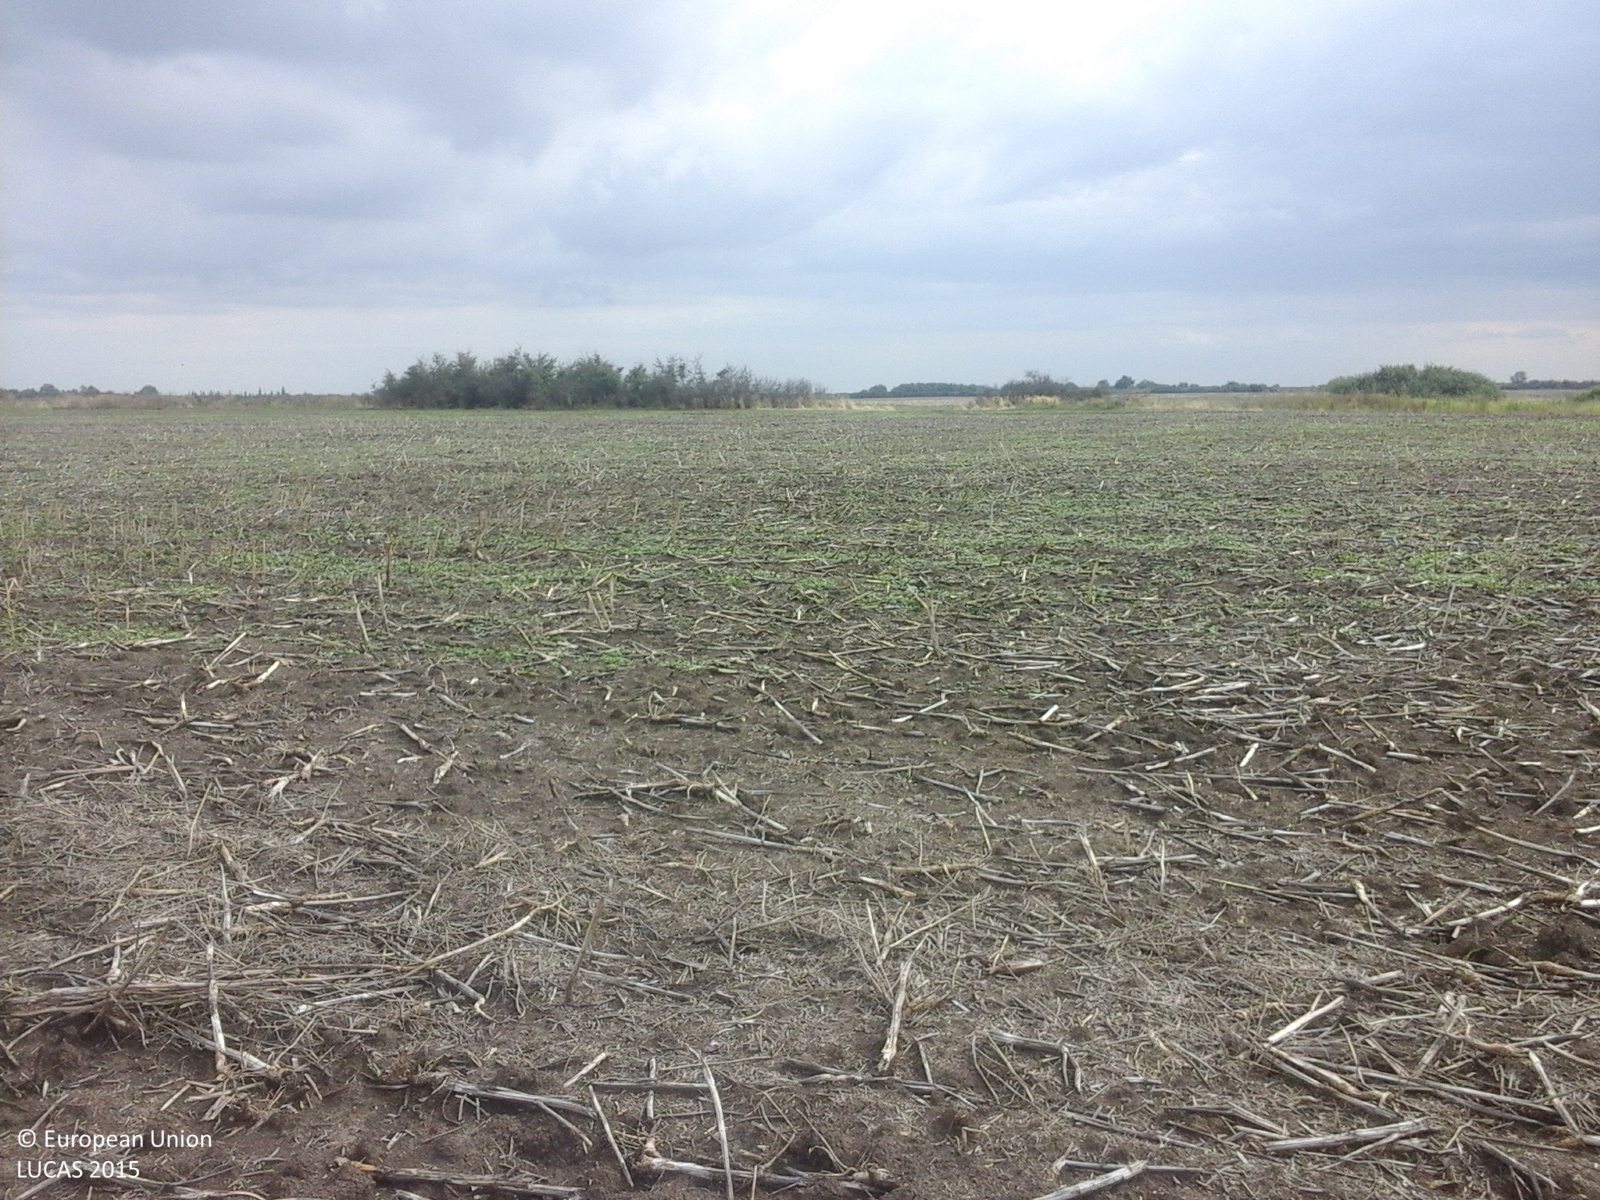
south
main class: Cropland
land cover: Rape and turnip rape
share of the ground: < 10 %
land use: Agriculture (excluding fallow land and kitchen gardens)
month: August
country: RO
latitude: 45.4663
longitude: 21.0649
